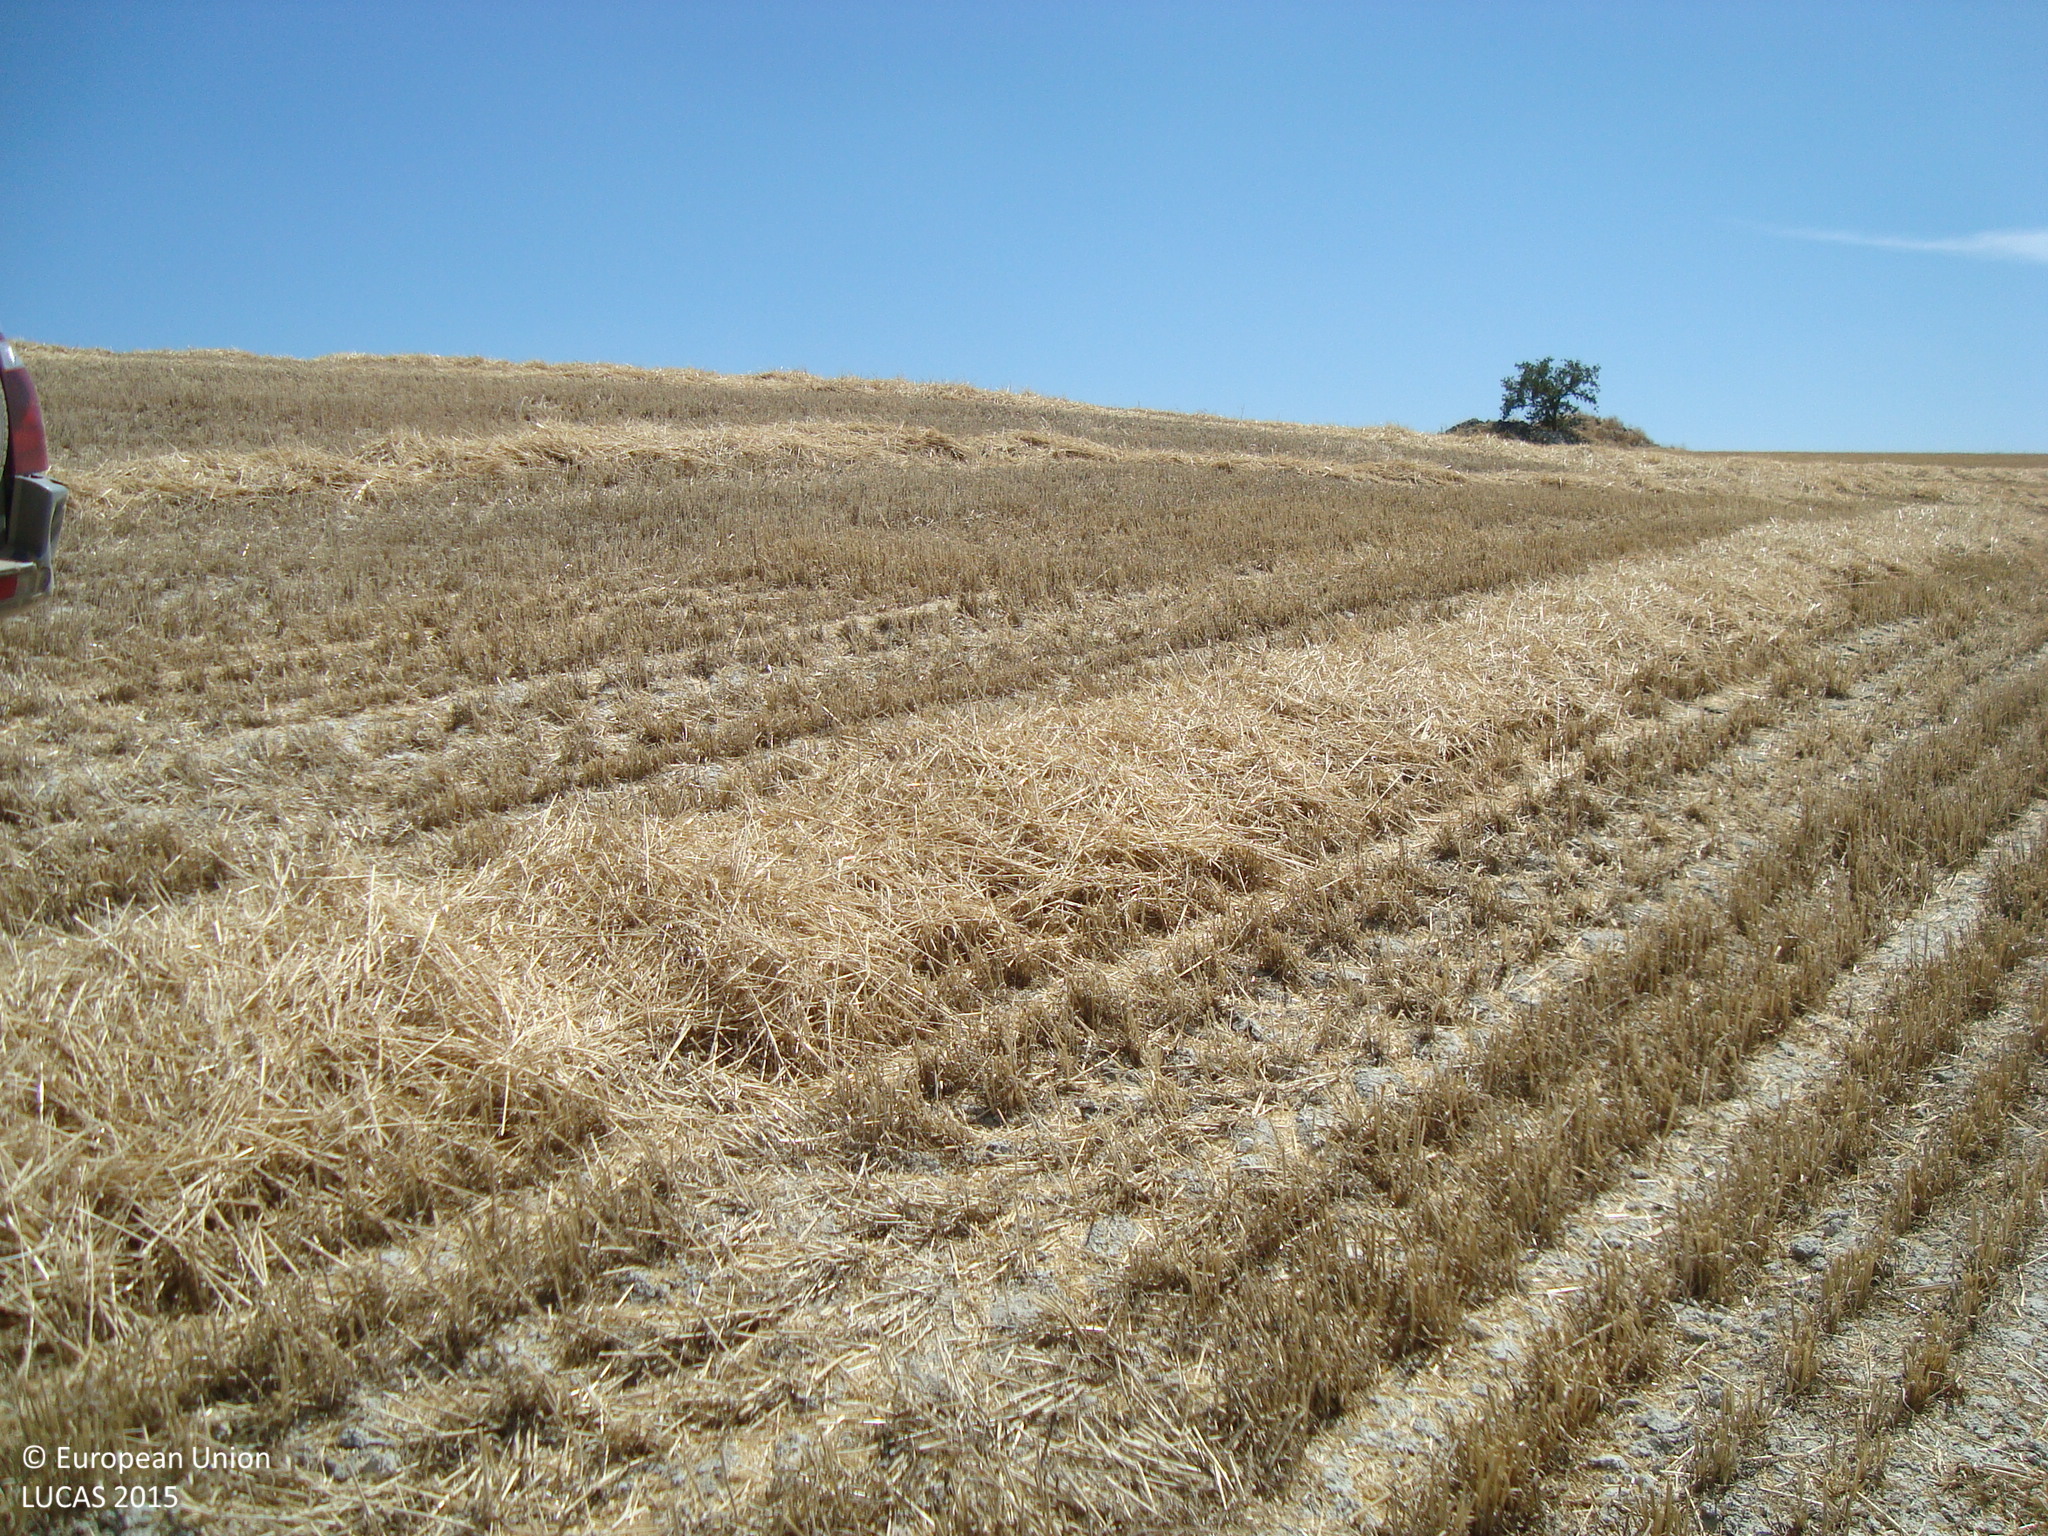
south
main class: Cropland
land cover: Common wheat
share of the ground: > 75 %
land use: Agriculture (excluding fallow land and kitchen gardens)
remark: Harvested field
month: July
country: ES
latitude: 41.9846
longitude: -4.1491
